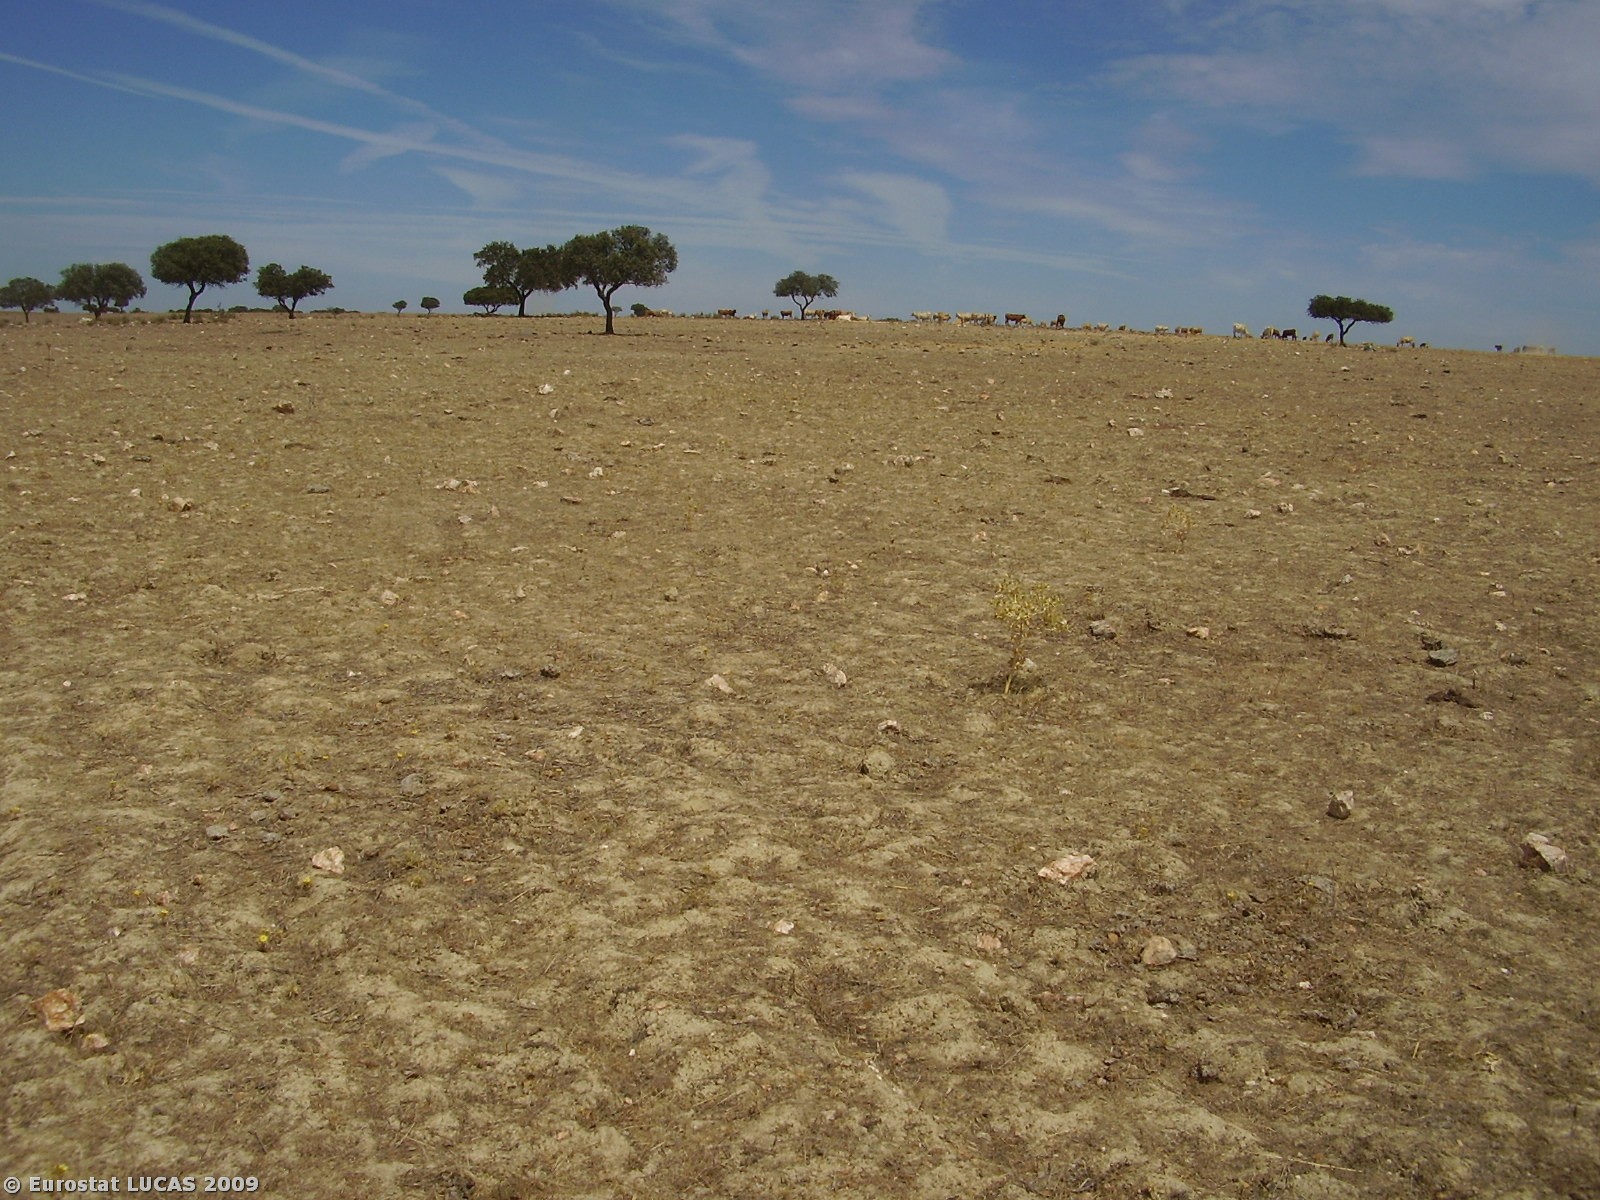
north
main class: Grassland
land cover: Grassland with sparse tree/shrub cover
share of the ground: > 75 %
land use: Fallow land
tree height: > 5 m
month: August
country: PT
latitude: 38.2255
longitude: -7.1621
